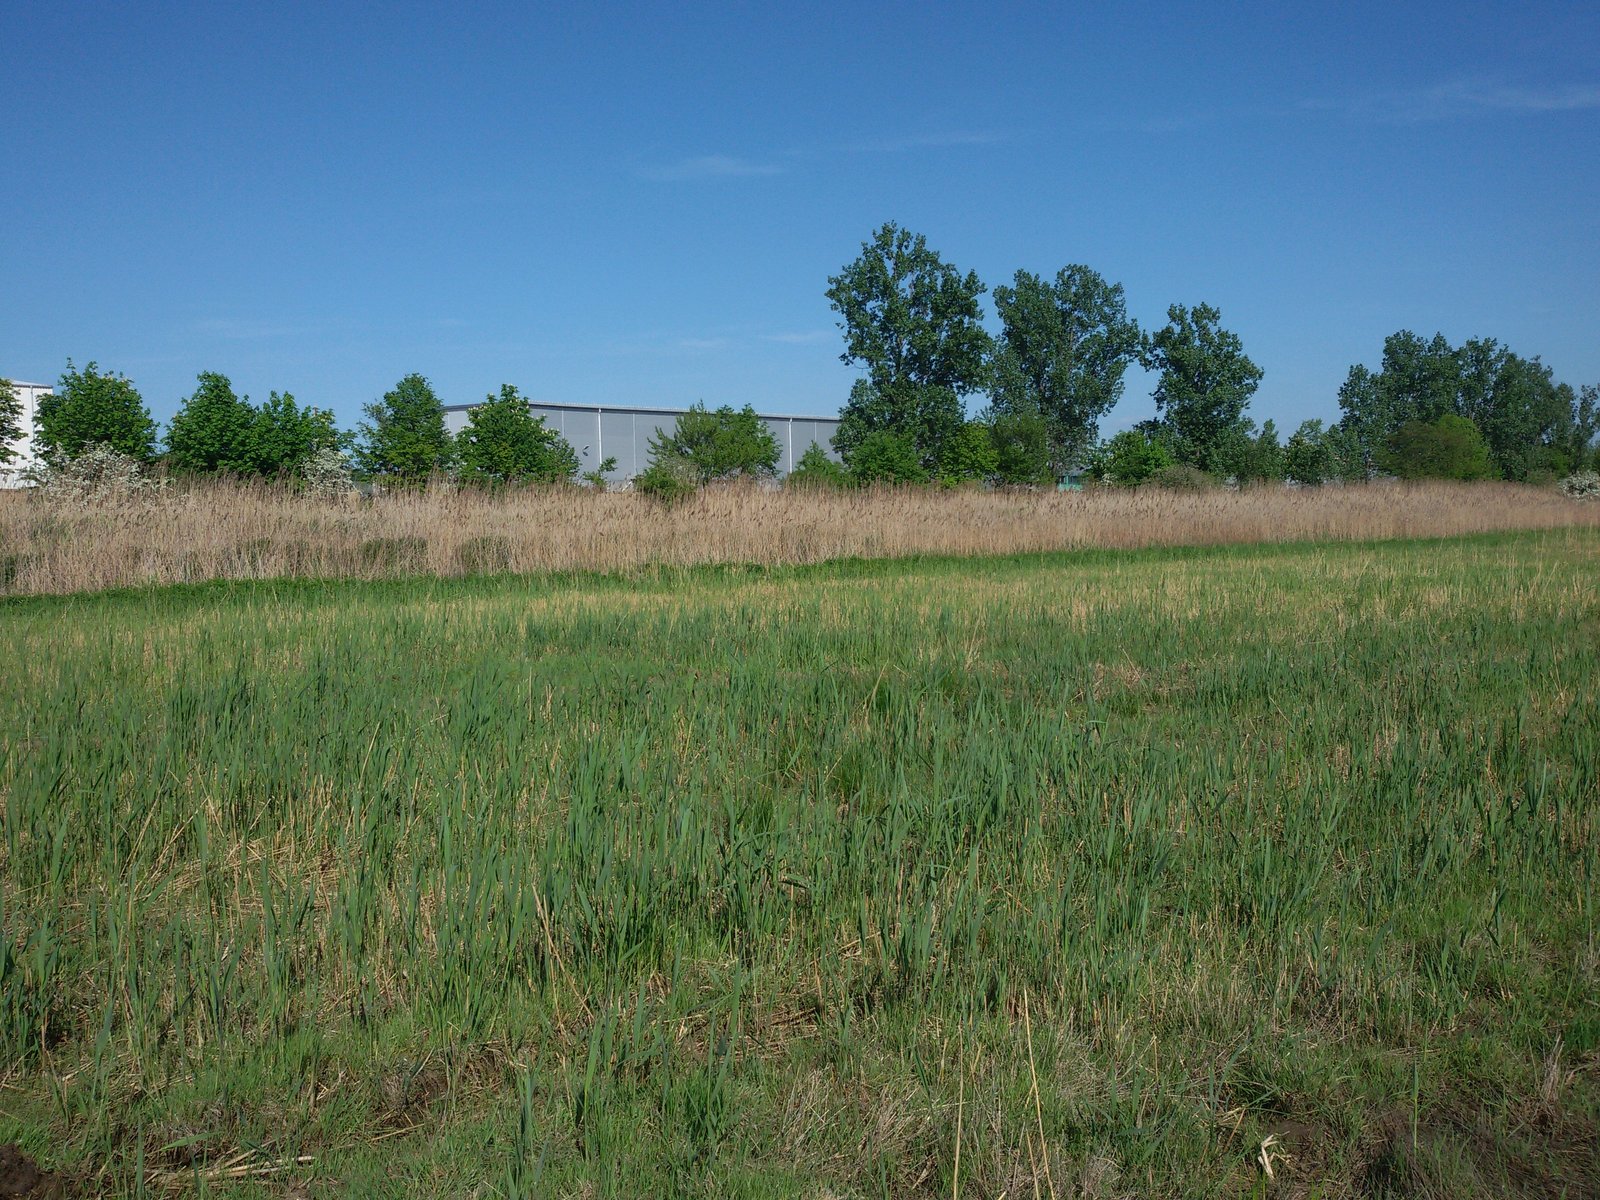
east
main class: Cropland
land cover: Temporary grasslands
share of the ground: > 75 %
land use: Agriculture (excluding fallow land and kitchen gardens)
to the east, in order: Temporary grasslands; Spontaneously vegetated surfaces; Tracks; Spontaneously vegetated surfaces; Inland fresh running water; Spontaneously vegetated surfaces; Lines of trees; Artificial constructions in urban areas; Inland fresh water bodies
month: May
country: PL
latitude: 50.3267
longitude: 18.6308
